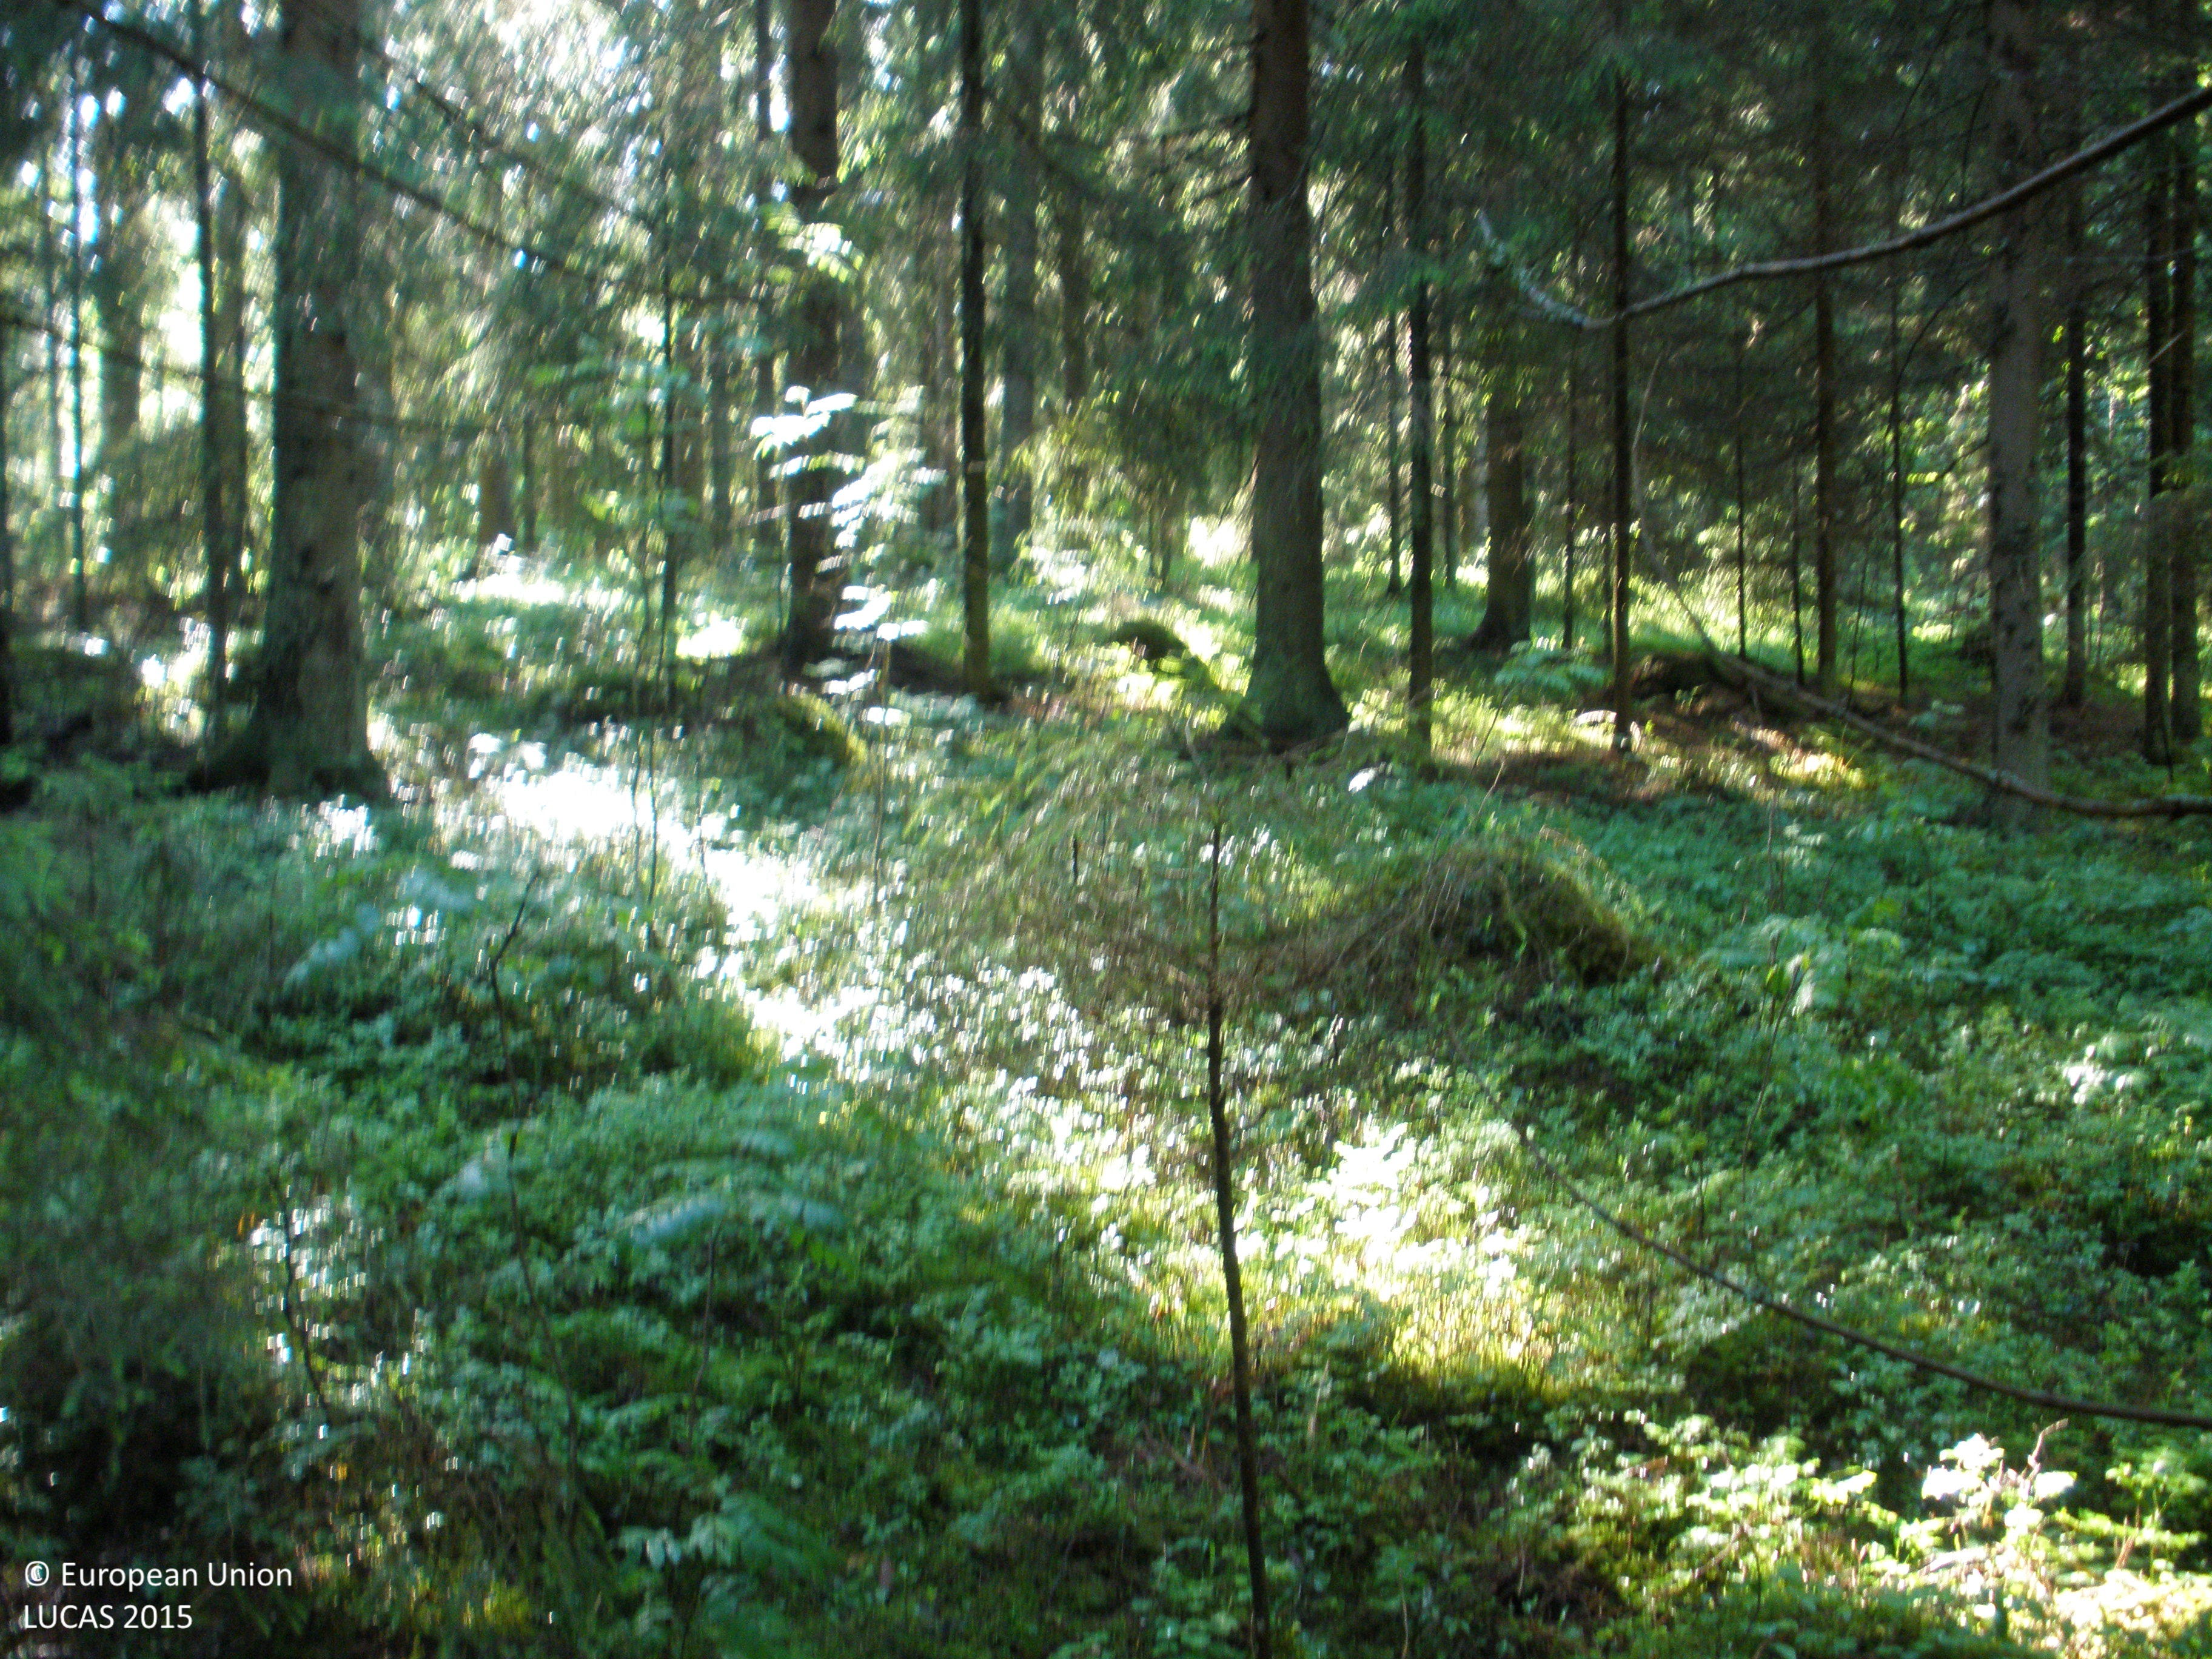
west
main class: Woodland
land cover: Spruce dominated coniferous woodland
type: boreal forest
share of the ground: > 75 %
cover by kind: coniferous forest trees 95 %, lichens and mosses 5 %
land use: Forestry
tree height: > 5 m
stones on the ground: < 10 %
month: June
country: FI
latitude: 60.9904
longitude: 23.5224
